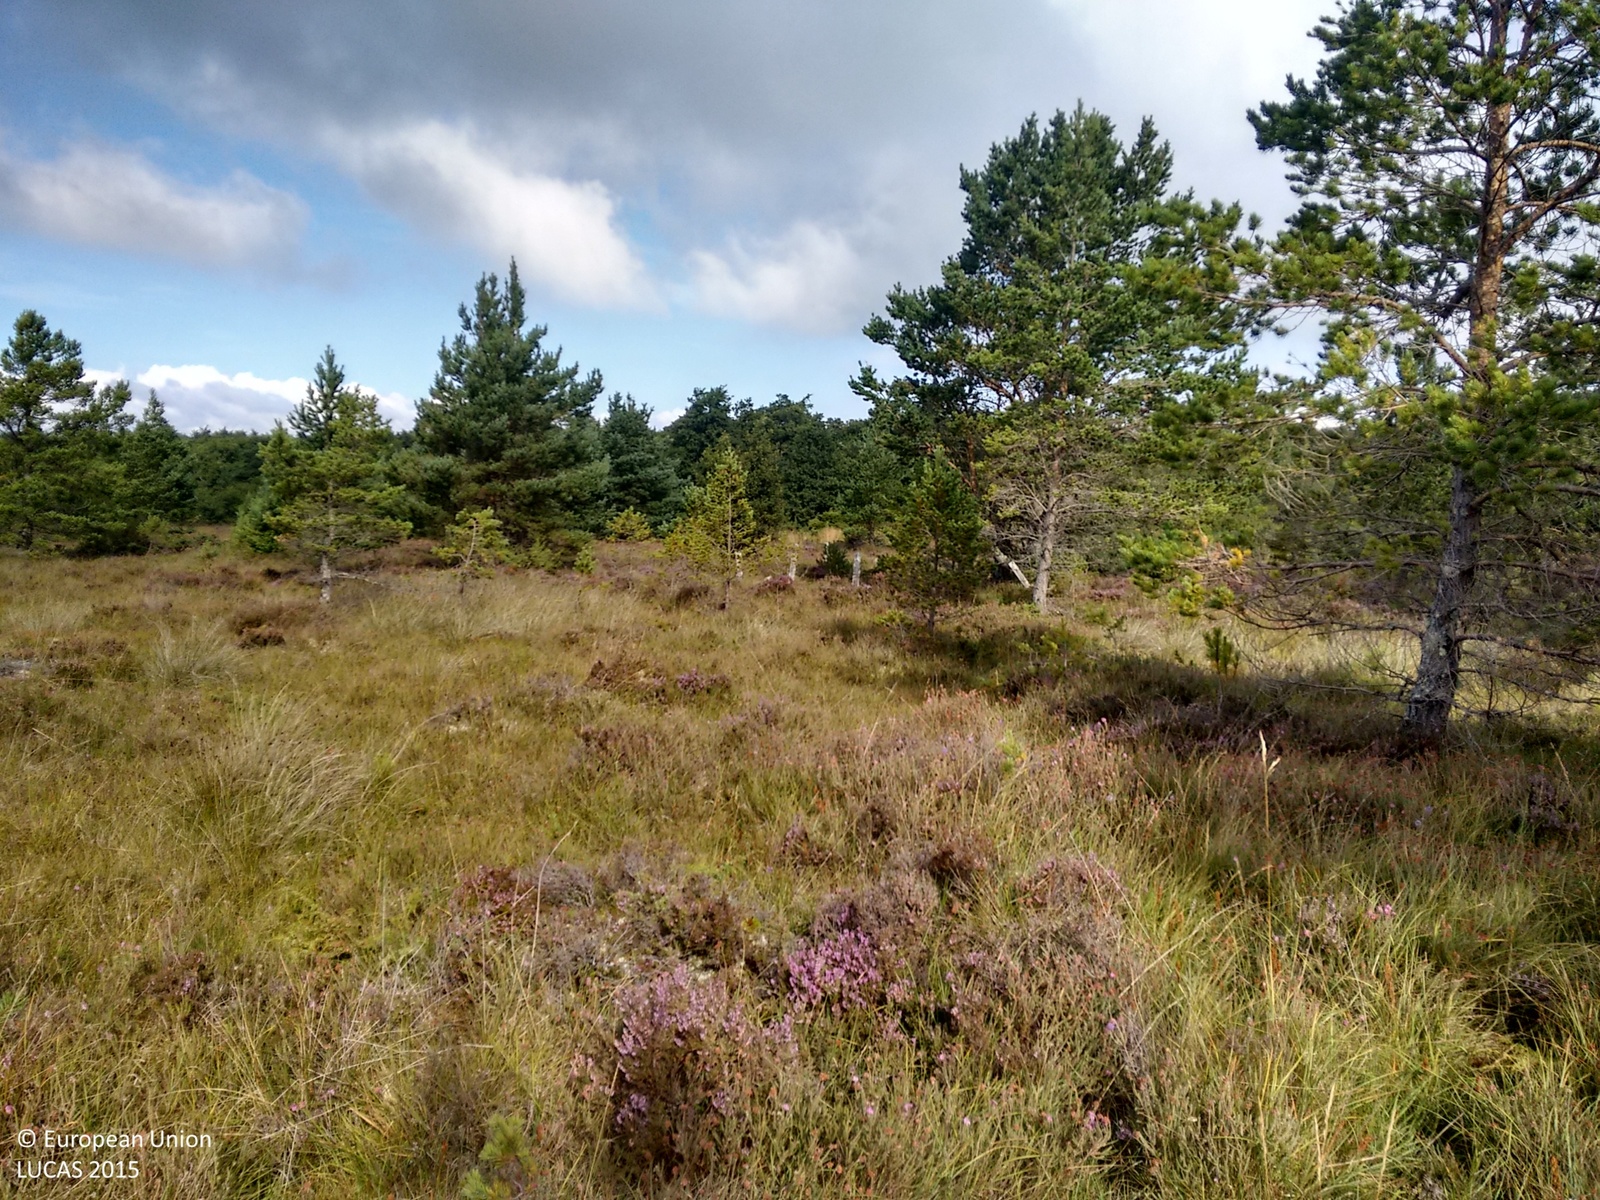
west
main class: Woodland
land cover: Pine dominated coniferous woodland
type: exotic forest
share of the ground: > 75 %
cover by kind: shrubs 40 %, coniferous forest trees 30 %, herbaceous plants 20 %, lichens and mosses 10 %
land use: Semi-natural and natural areas not in use
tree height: < 5 m
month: September
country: GB
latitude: 57.4457
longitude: -4.1638
